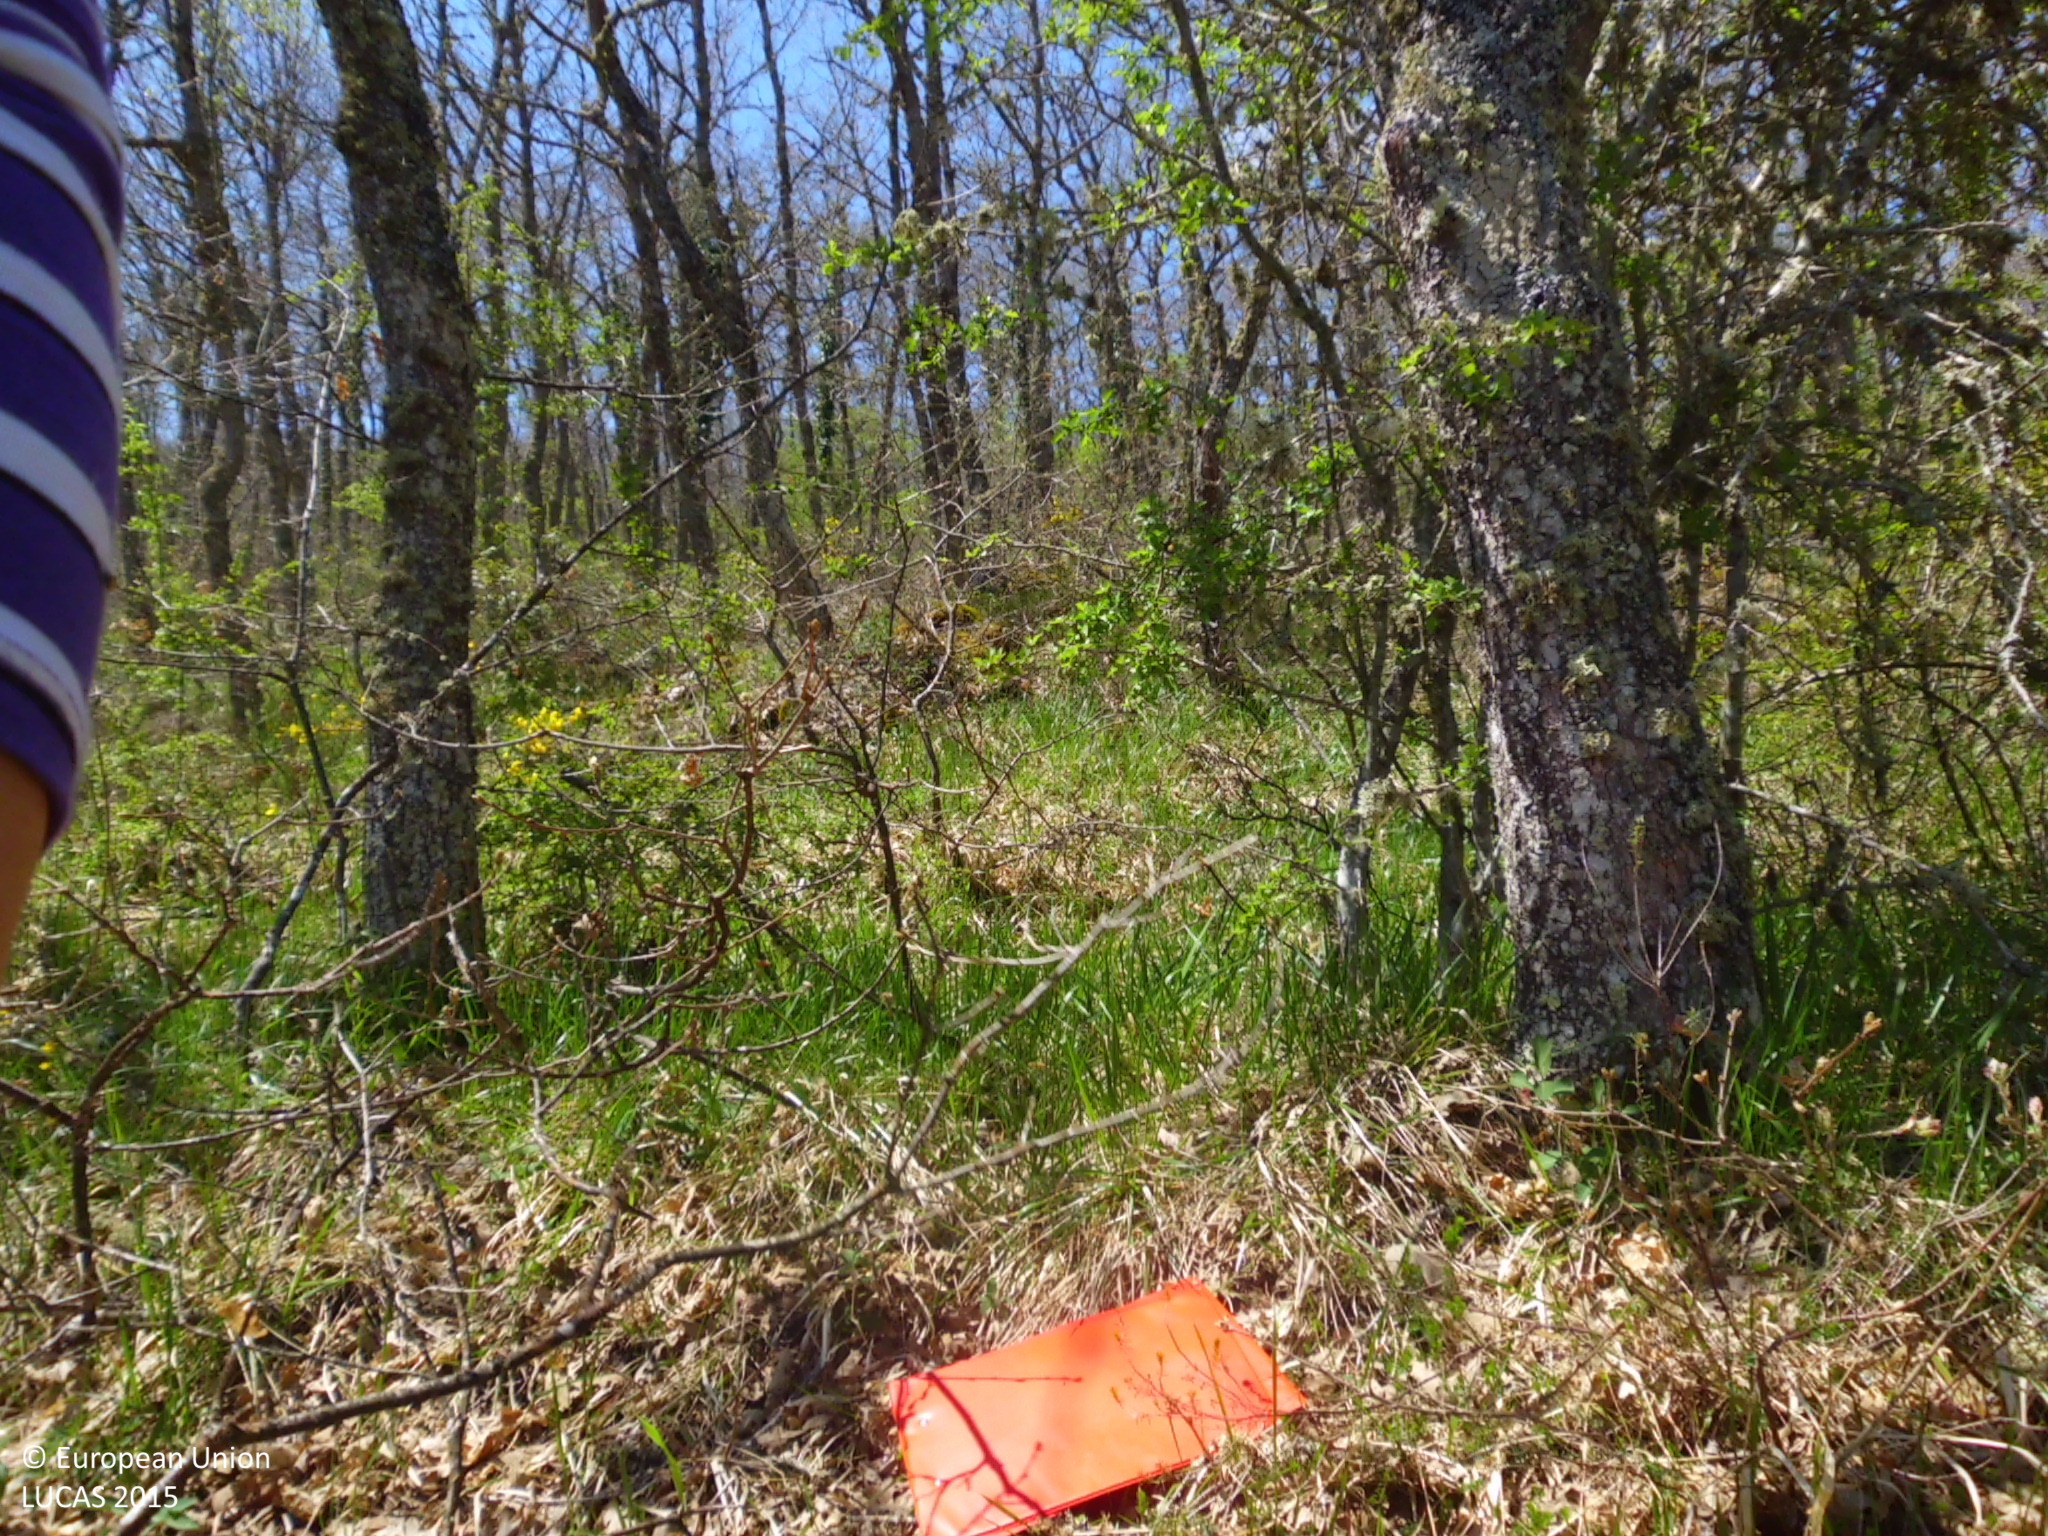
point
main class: Woodland
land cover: Broadleaved woodland
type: acidophilous oak and oak-birch forest
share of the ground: 50 - 75 %
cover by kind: broadleaved forest trees 65 %, herbaceous plants 20 %, shrubs 15 %
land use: Semi-natural and natural areas not in use
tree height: > 5 m
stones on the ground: 25 - 50 %
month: May
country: ES
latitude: 42.8960
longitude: -4.0448
